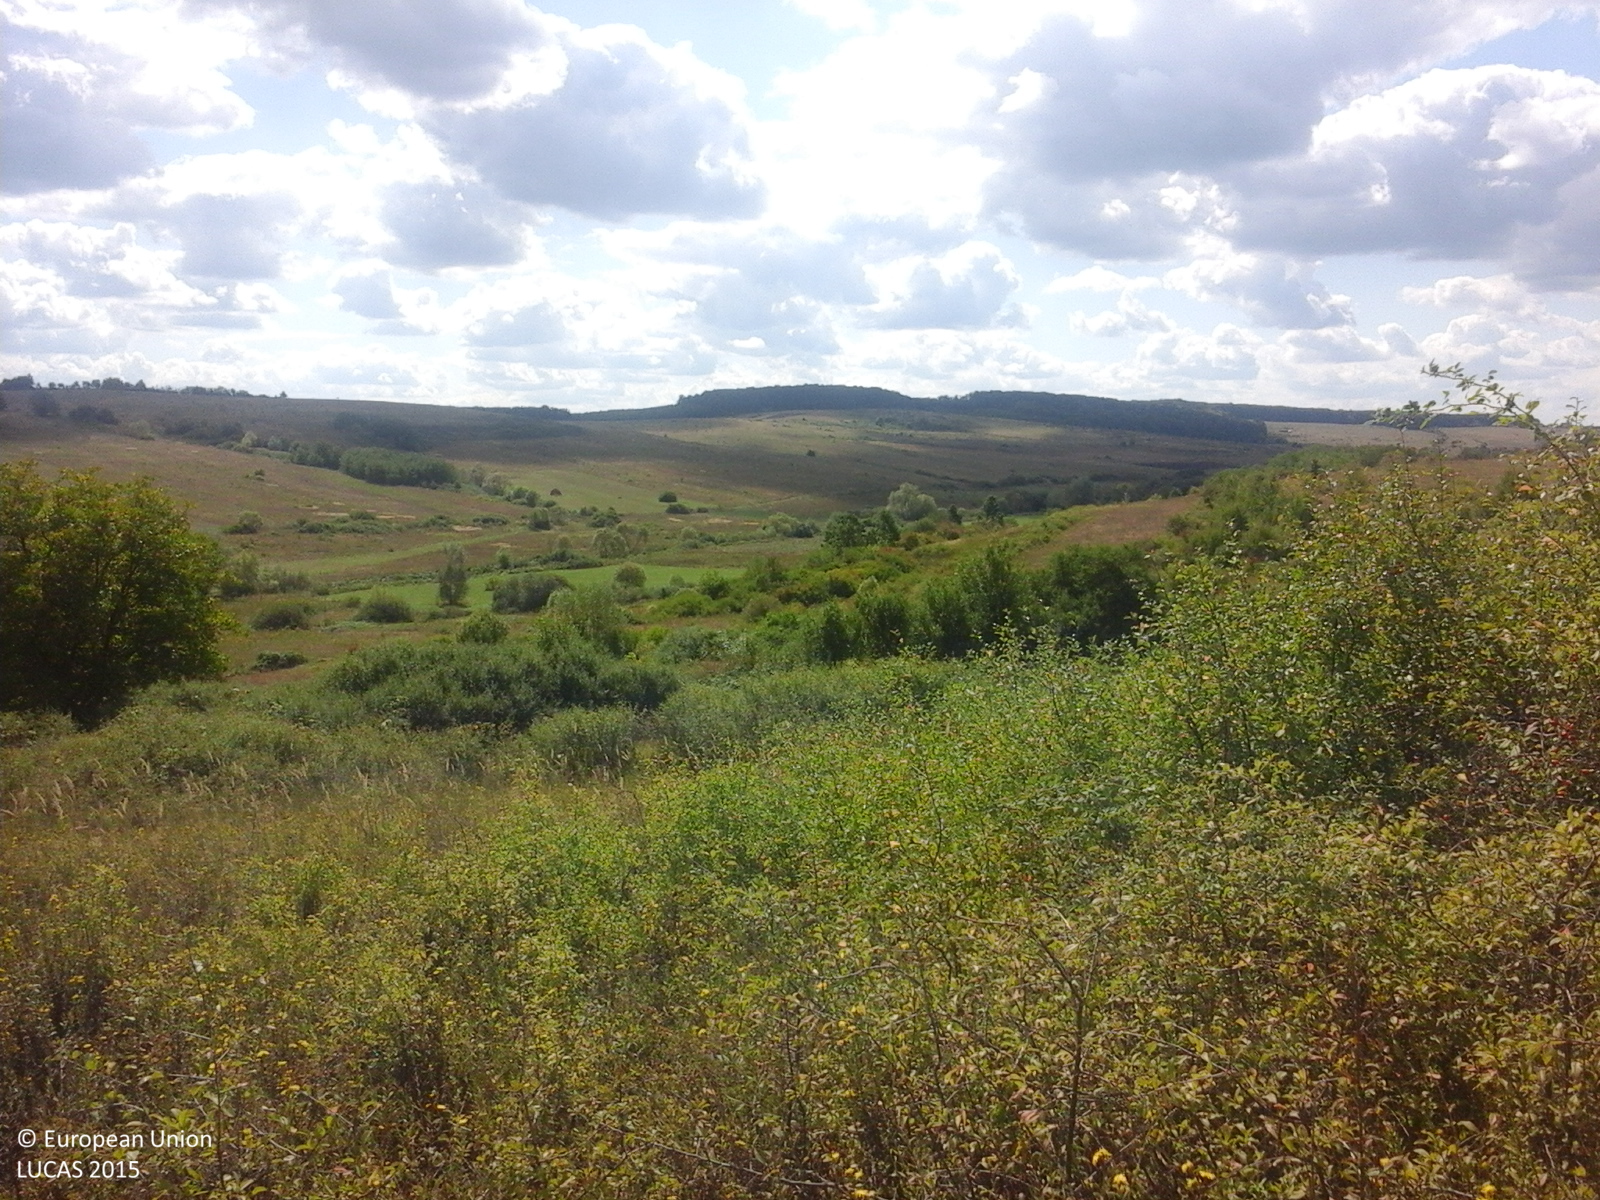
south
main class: Grassland
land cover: Spontaneously vegetated surfaces
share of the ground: > 75 %
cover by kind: herbaceous plants 100 %
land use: Fallow land
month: September
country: RO
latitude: 47.4585
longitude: 23.0789
